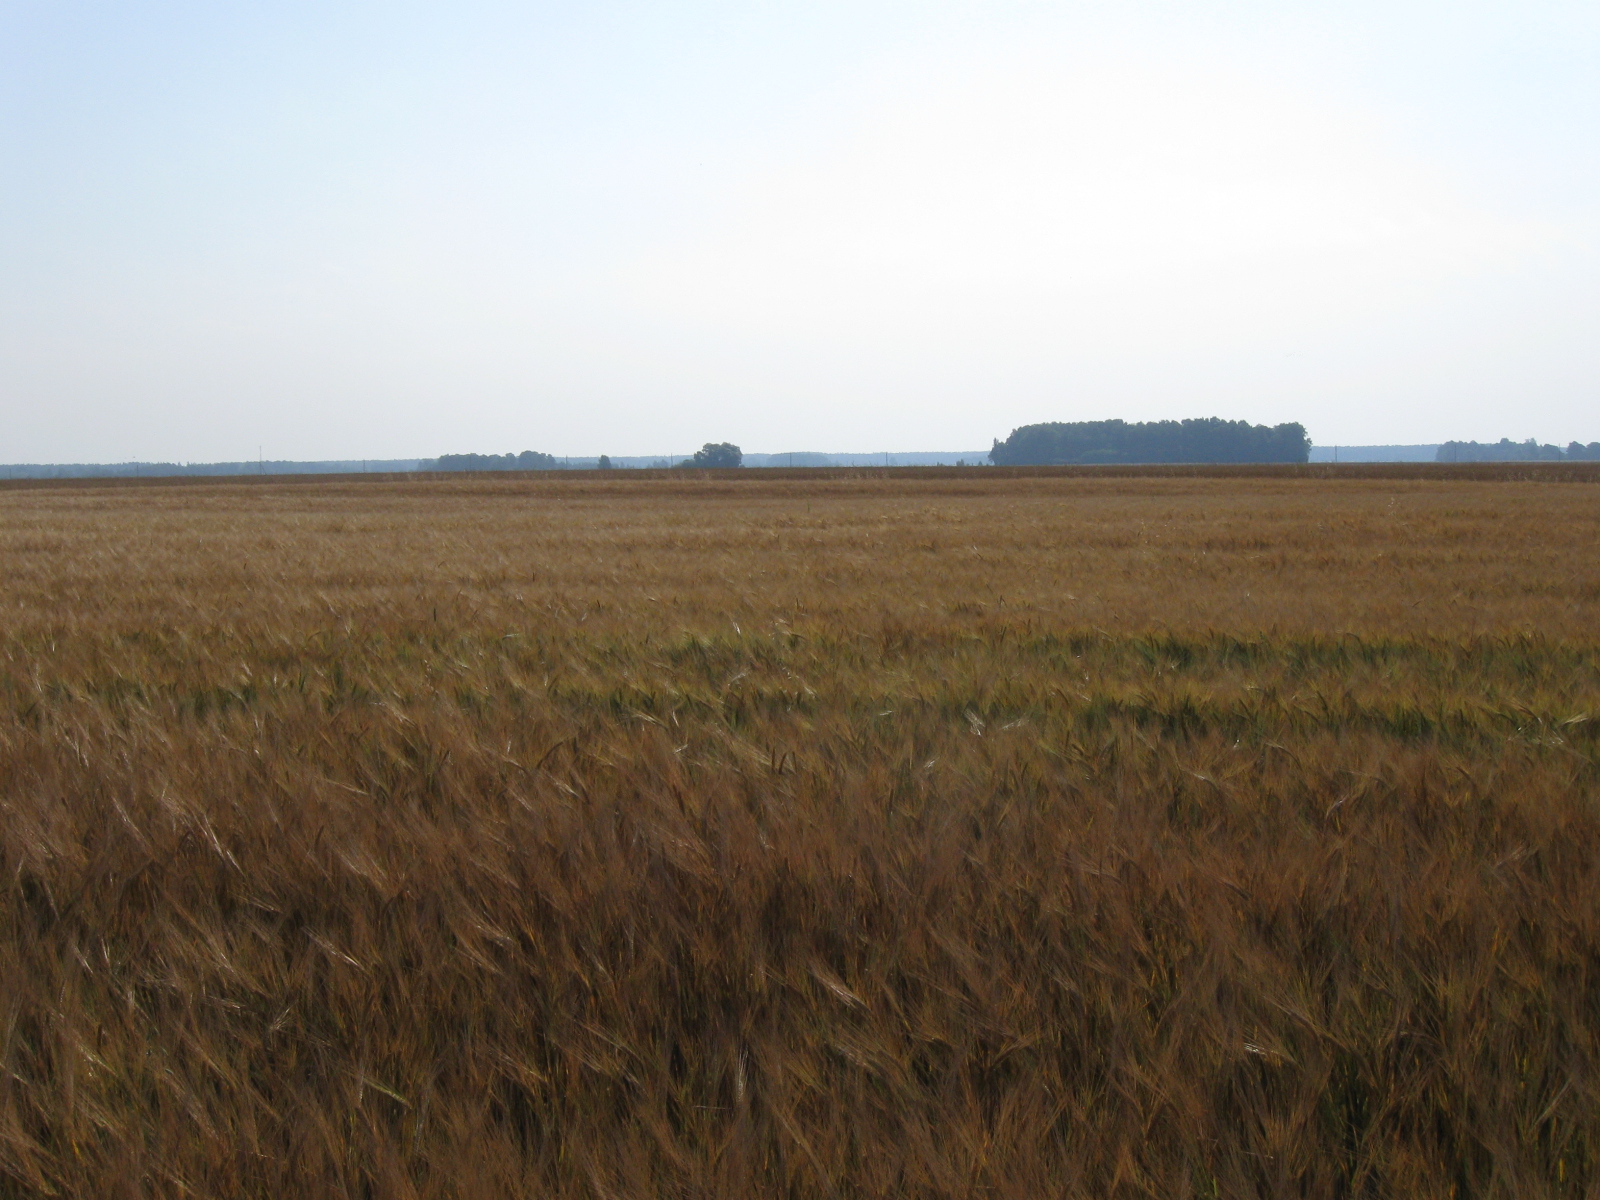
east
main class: Cropland
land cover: Barley
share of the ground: > 75 %
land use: Agriculture (excluding fallow land and kitchen gardens)
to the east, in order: Barley; Common wheat
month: August
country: LT
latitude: 54.8349
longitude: 23.2953
